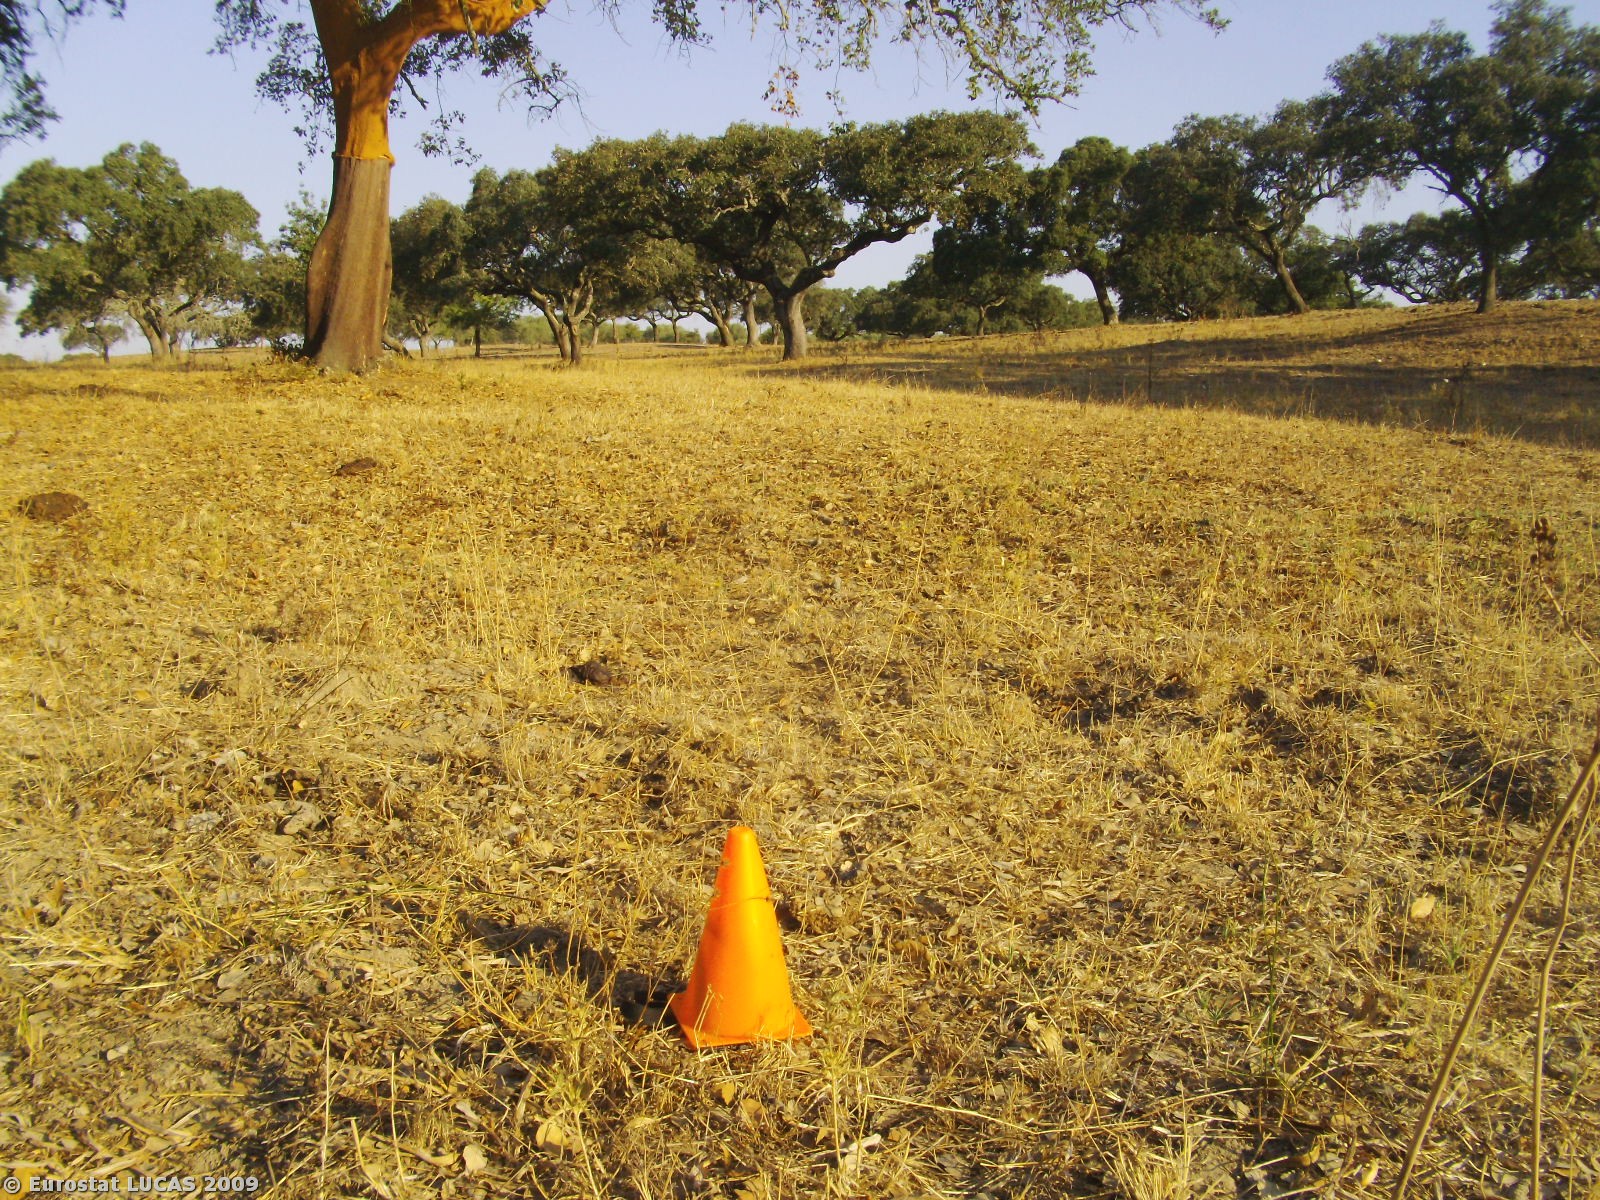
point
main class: Woodland
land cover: Broadleaved woodland
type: broadleaved evergreen forest
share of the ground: 25 - 50 %
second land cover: Spontaneously vegetated surfaces
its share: 25 - 50 %
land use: Forestry
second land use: Fallow land
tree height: > 5 m
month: August
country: PT
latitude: 38.0301
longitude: -8.4879
